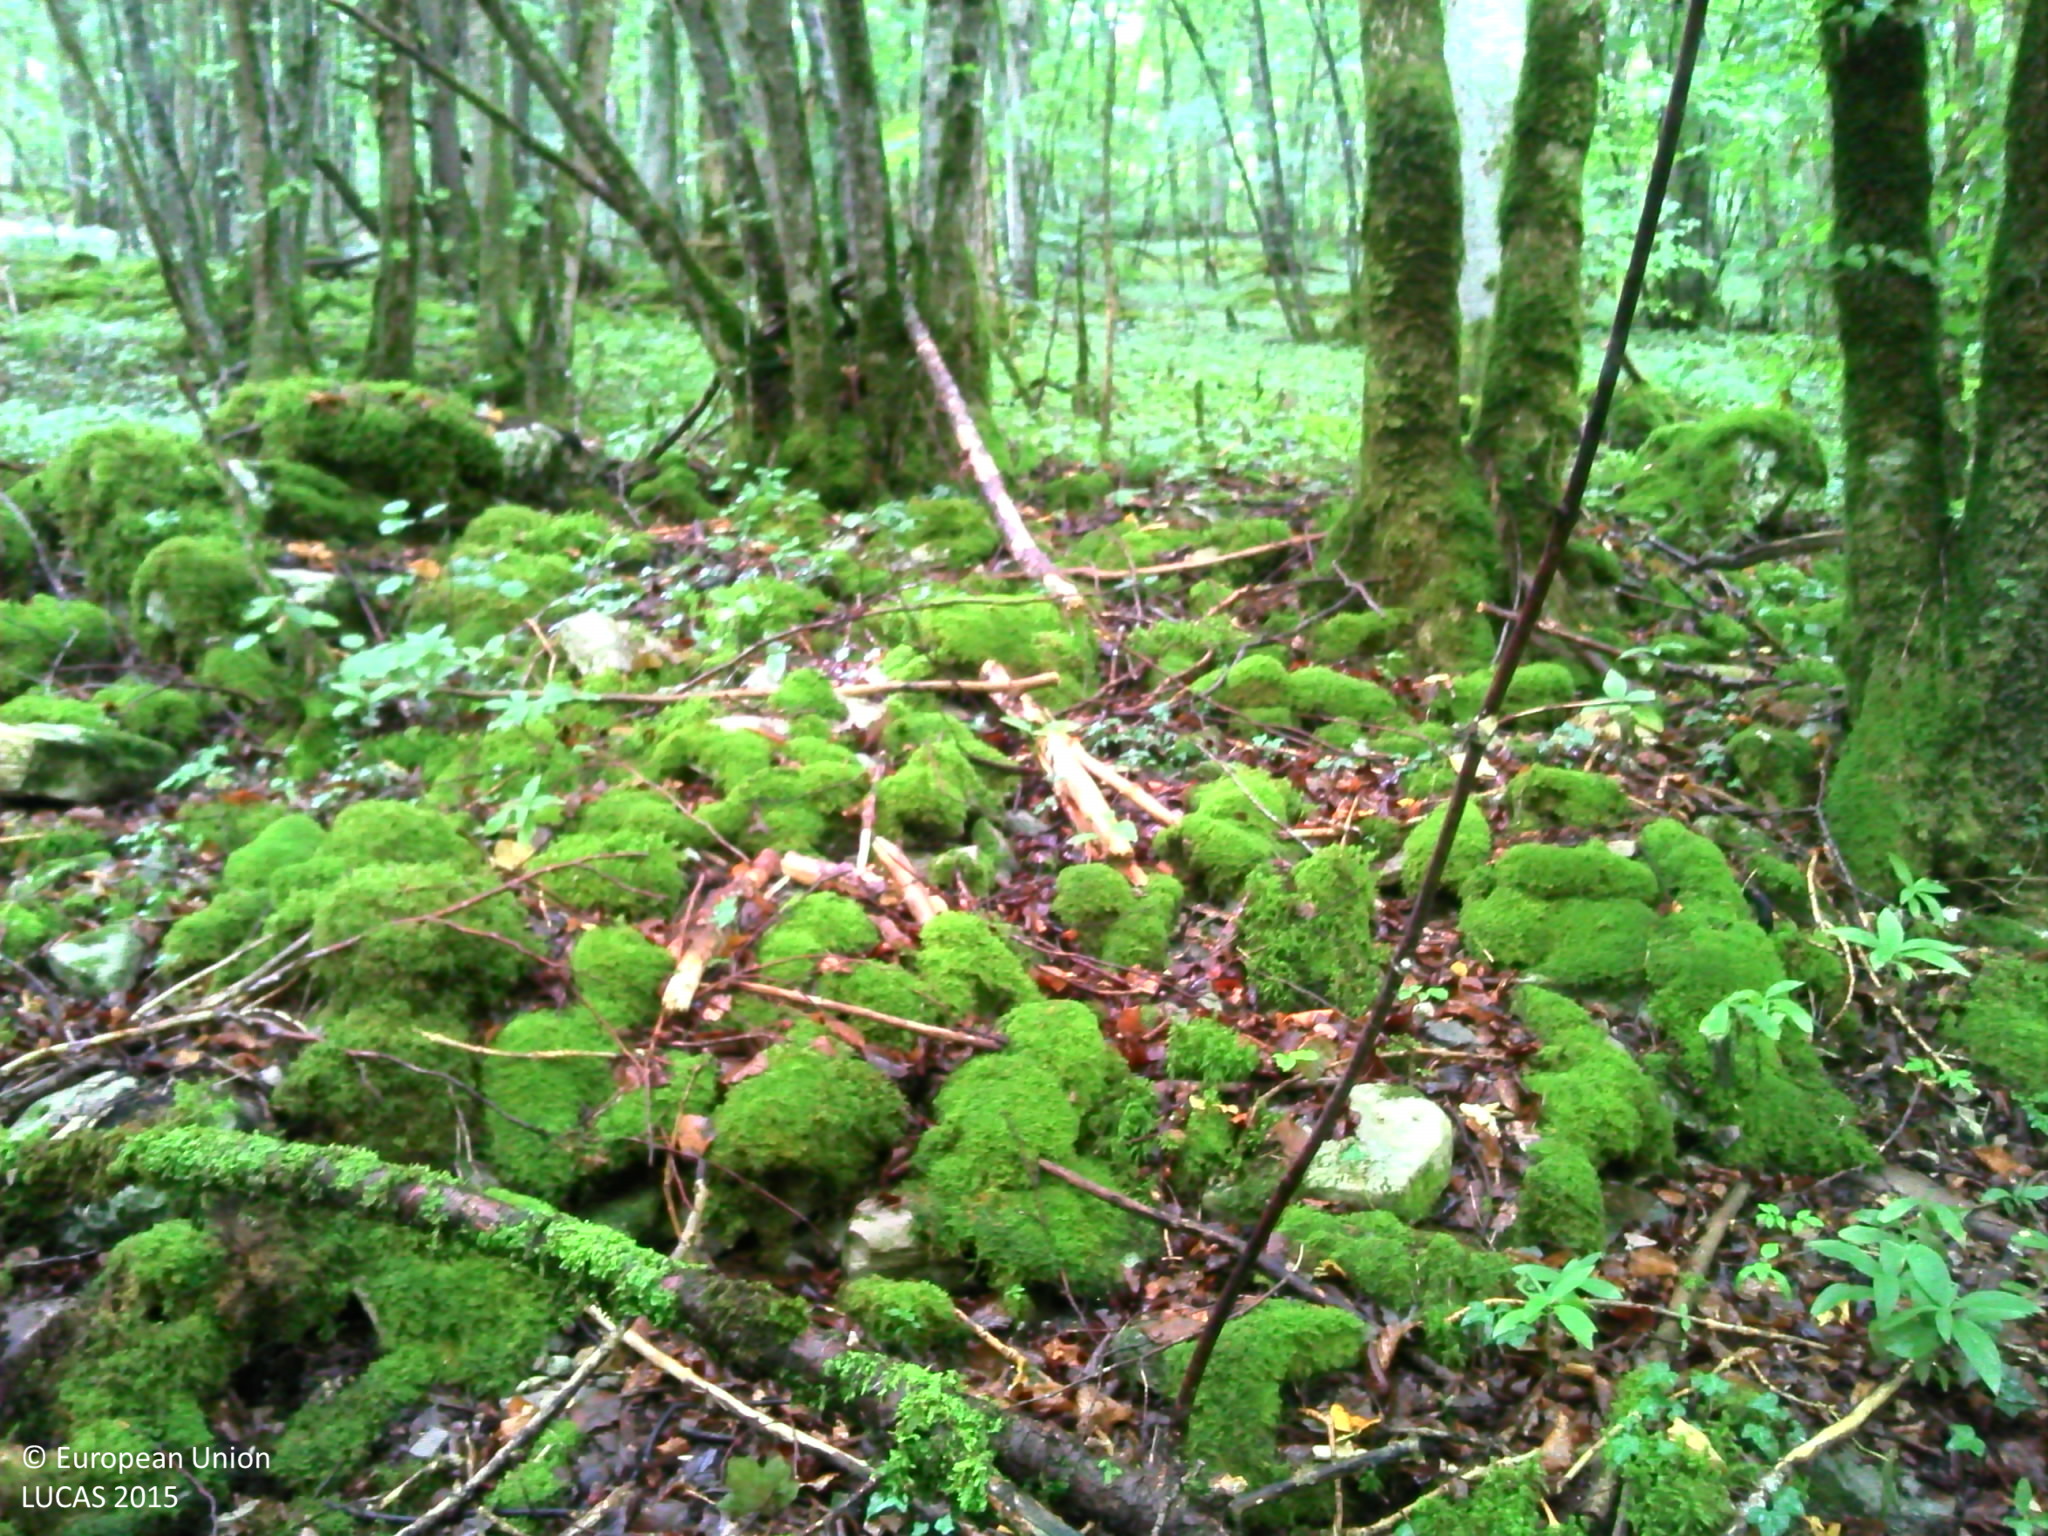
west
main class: Woodland
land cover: Broadleaved woodland
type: mesophytic deciduous forest
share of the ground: > 75 %
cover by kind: broadleaved forest trees 75 %, herbaceous plants 15 %, shrubs 10 %
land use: Forestry
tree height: > 5 m
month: September
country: FR
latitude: 47.1408
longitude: 4.7128
